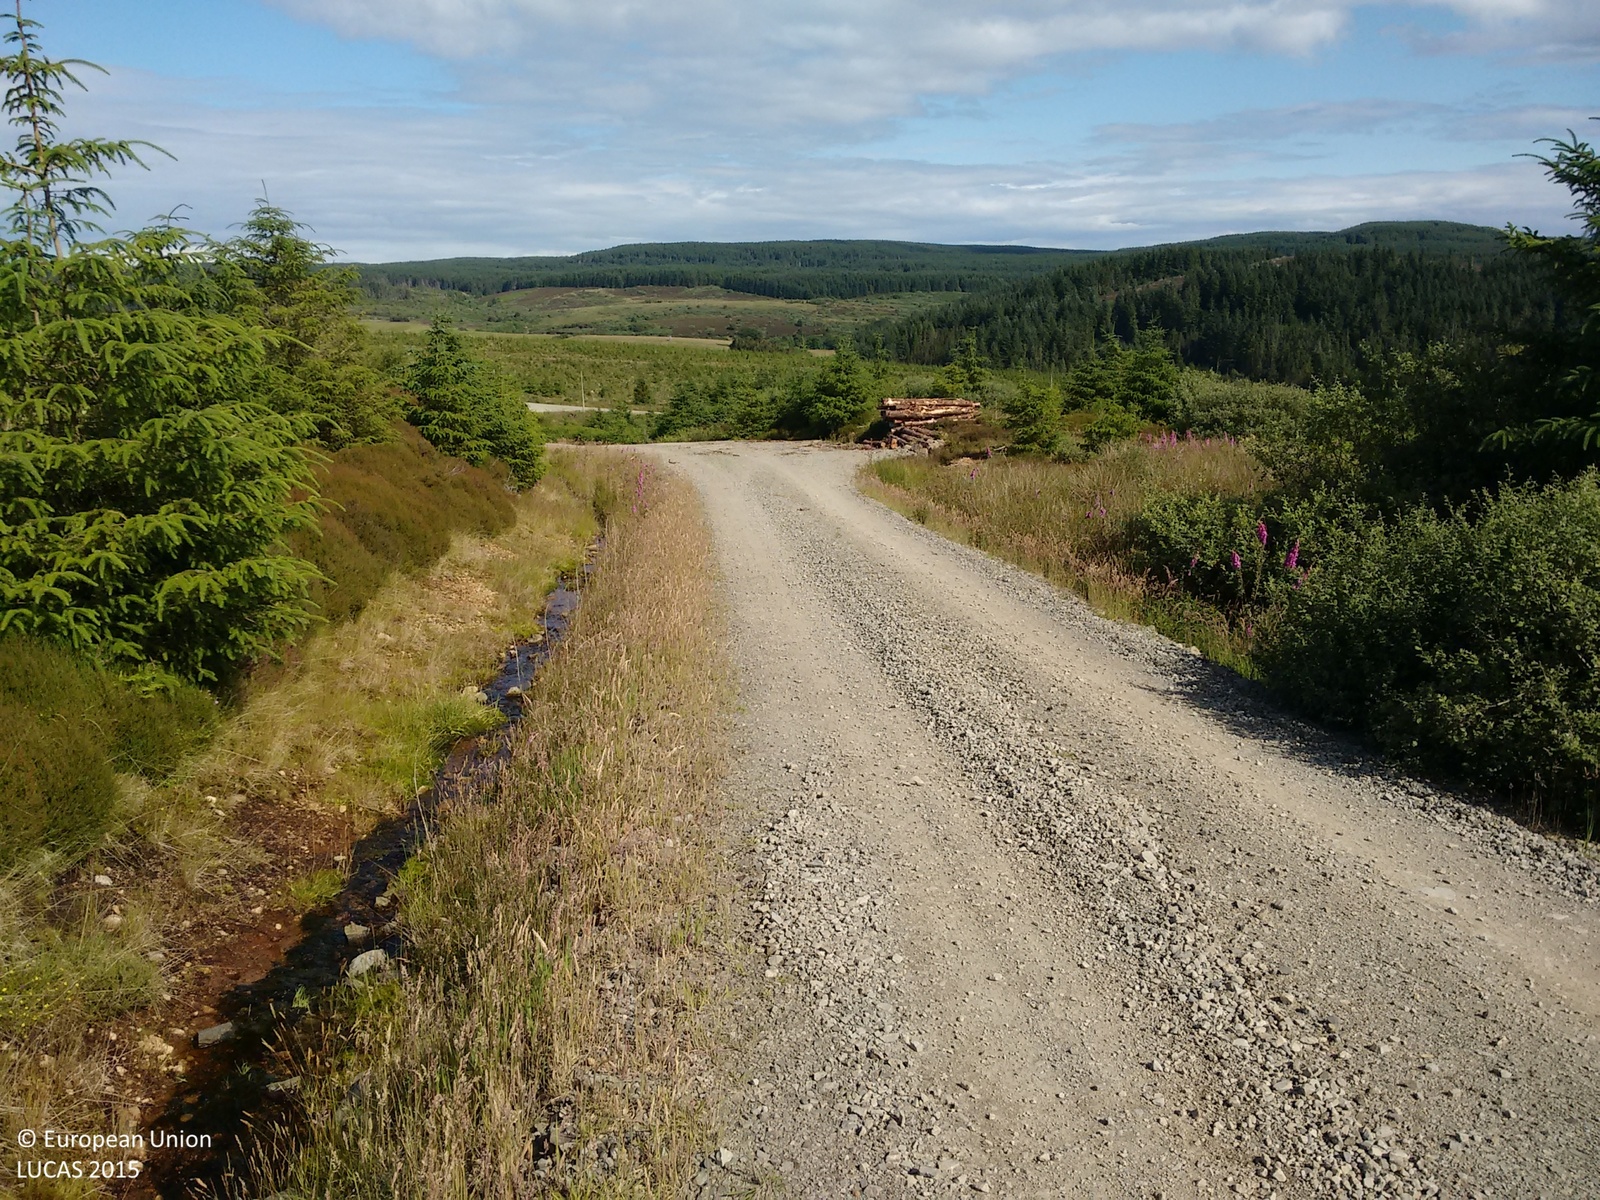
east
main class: Shrubland
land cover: Shrubland with sparse tree cover
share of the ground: > 75 %
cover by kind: shrubs 95 %, coniferous forest trees 5 %
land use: Semi-natural and natural areas not in use
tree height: < 5 m
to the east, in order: Shrubland with sparse tree cover; Rivers and streams; Spruce dominated coniferous woodland
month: July
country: GB
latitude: 55.4768
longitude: -5.1945
